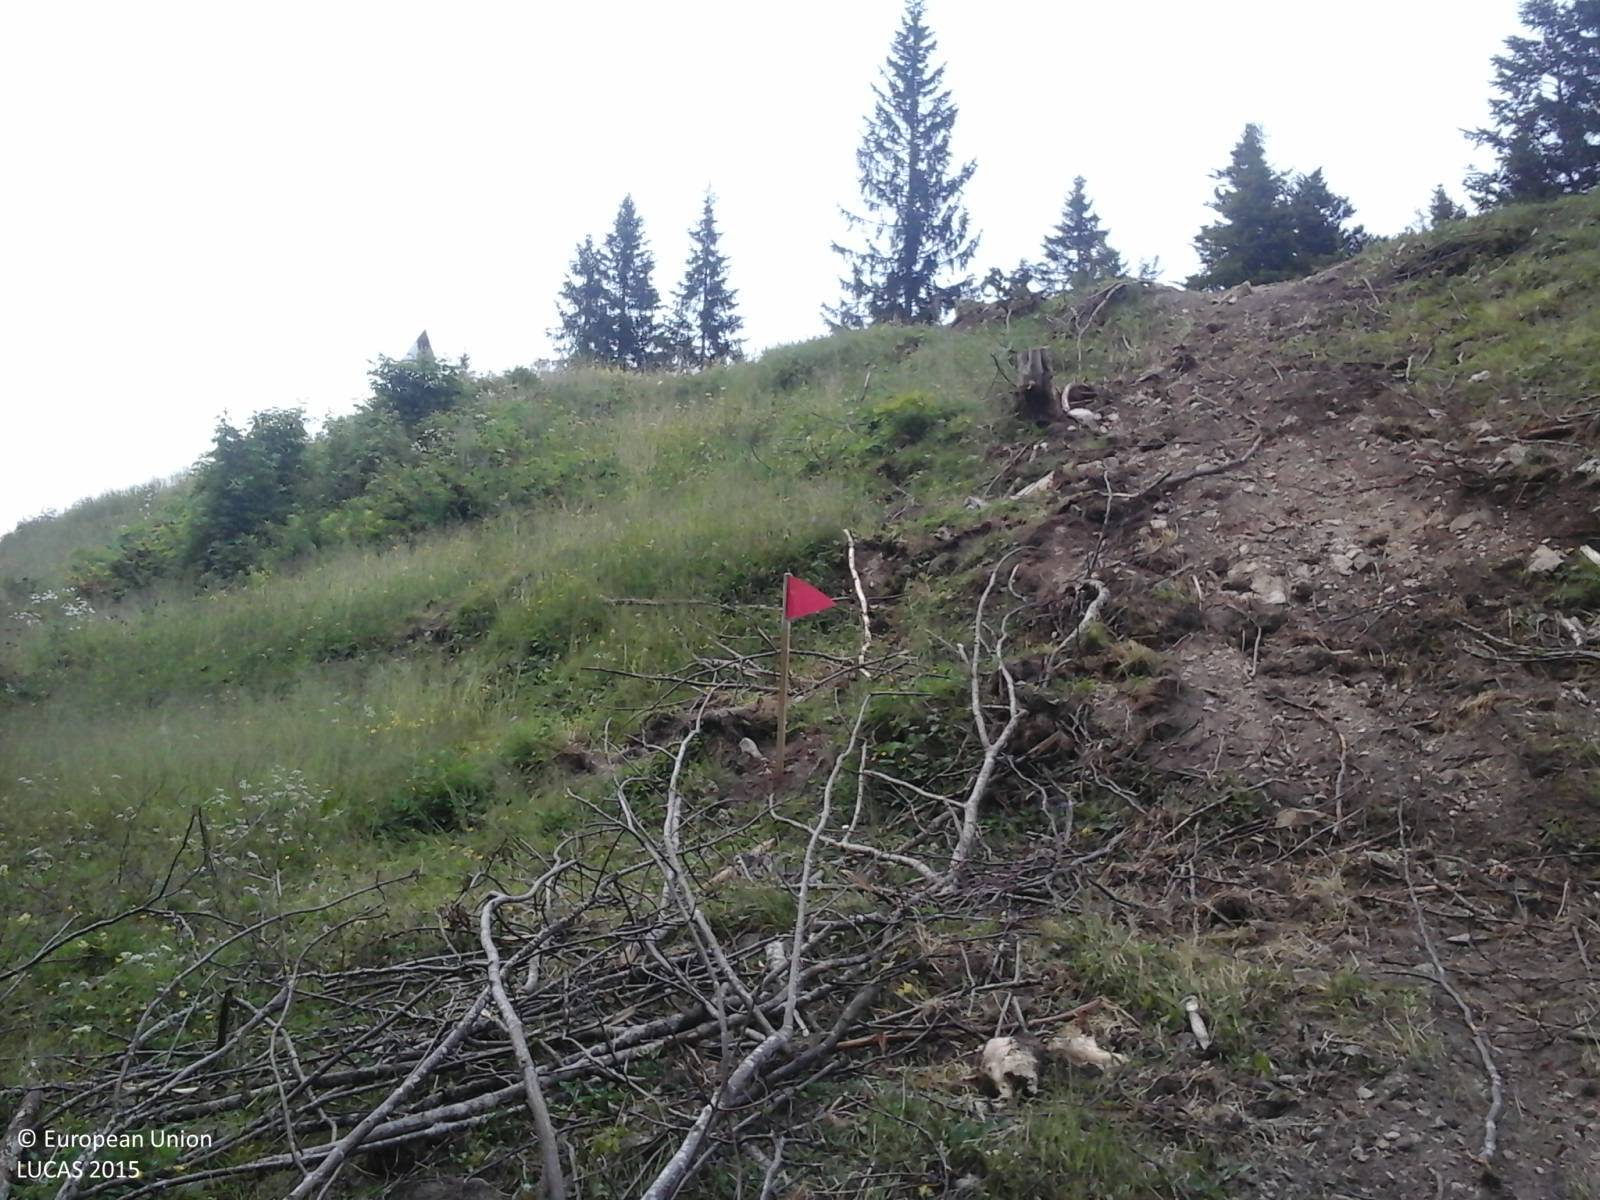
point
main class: Grassland
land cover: Grassland without tree/shrub cover
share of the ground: > 75 %
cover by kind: herbaceous plants 100 %
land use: Agriculture (excluding fallow land and kitchen gardens)
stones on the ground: 10 - 25 %
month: July
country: IT
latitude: 46.4242
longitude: 12.7427
